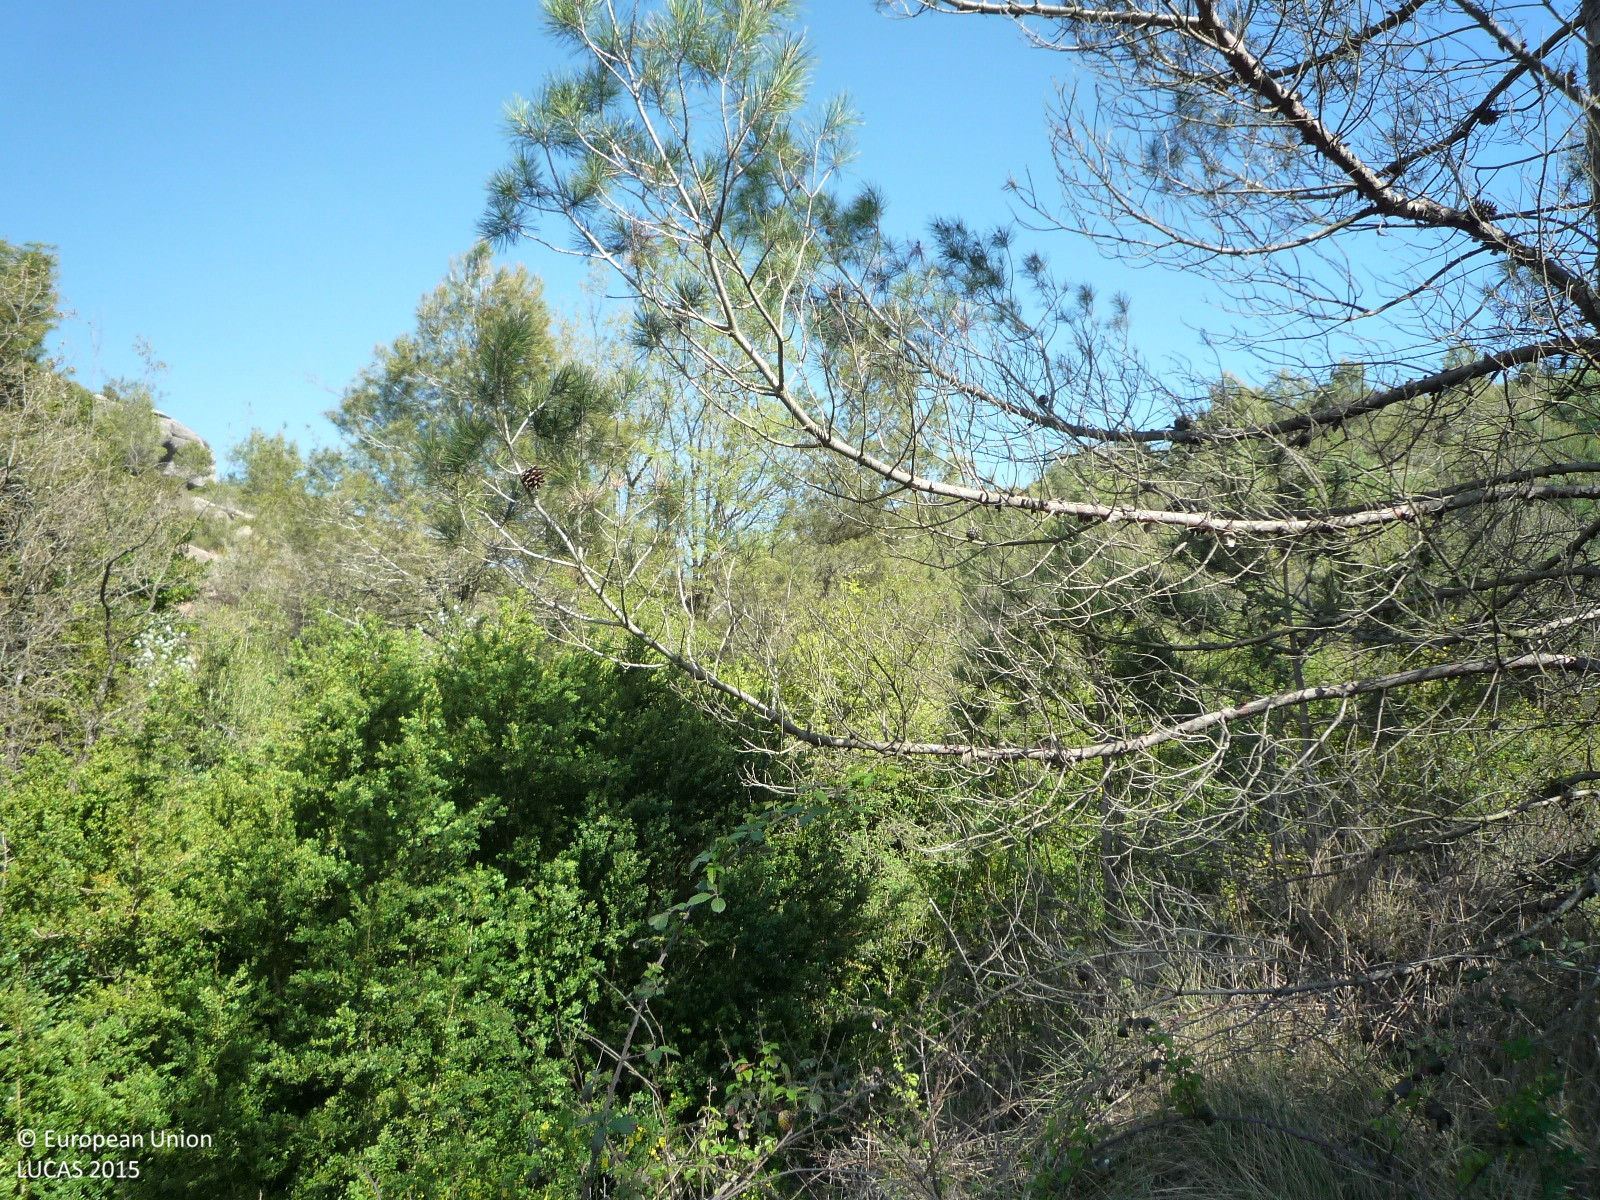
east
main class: Woodland
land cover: Pine dominated mixed woodland
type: coniferous forest of the mediterranean region
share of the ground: > 75 %
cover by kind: coniferous forest trees 75 %, broadleaved forest trees 25 %
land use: Forestry
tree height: < 5 m
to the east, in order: Pine dominated mixed woodland; Rivers and streams; Pine dominated mixed woodland; Tracks; Shrubland with sparse tree cover; Rock outcrops; Shrubland with sparse tree cover; Rock outcrops; Shrubland with sparse tree cover
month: April
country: ES
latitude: 41.6709
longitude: 1.6192
